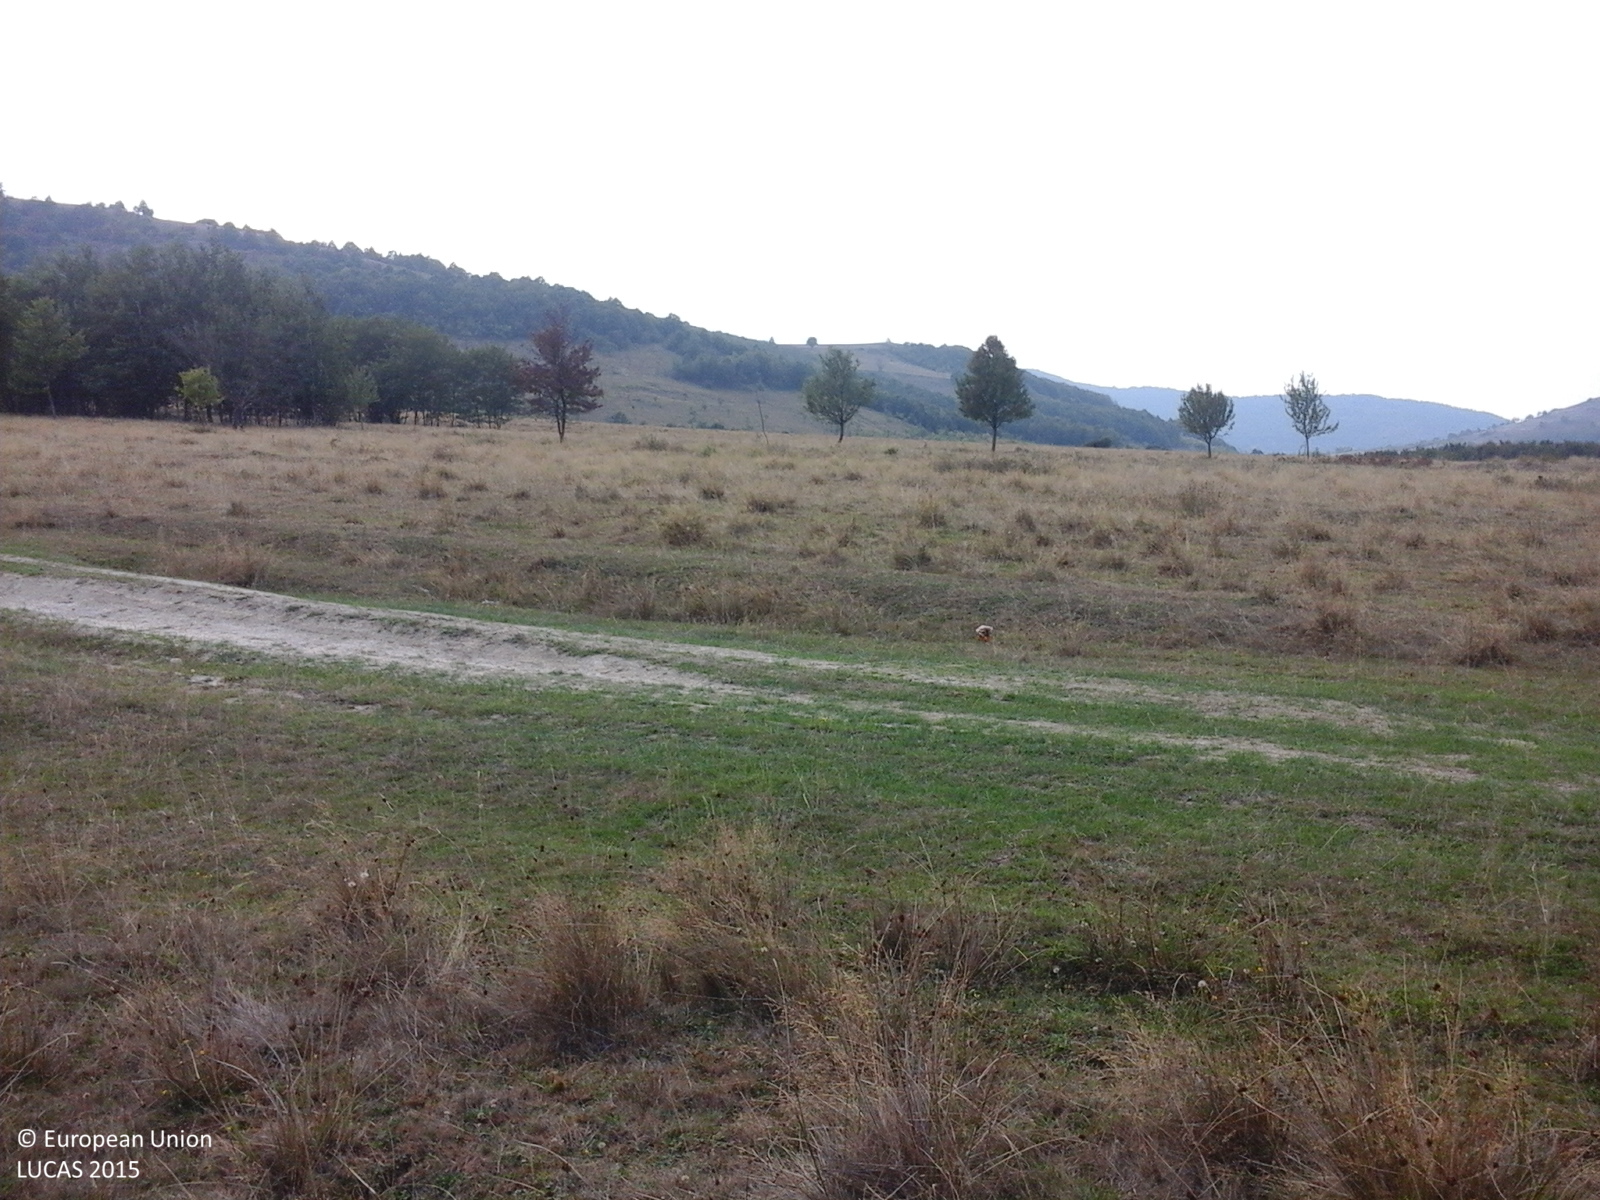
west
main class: Grassland
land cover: Grassland without tree/shrub cover
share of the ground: > 75 %
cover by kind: herbaceous plants 100 %
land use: Agriculture (excluding fallow land and kitchen gardens)
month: August
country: RO
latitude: 46.2655
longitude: 22.2294
